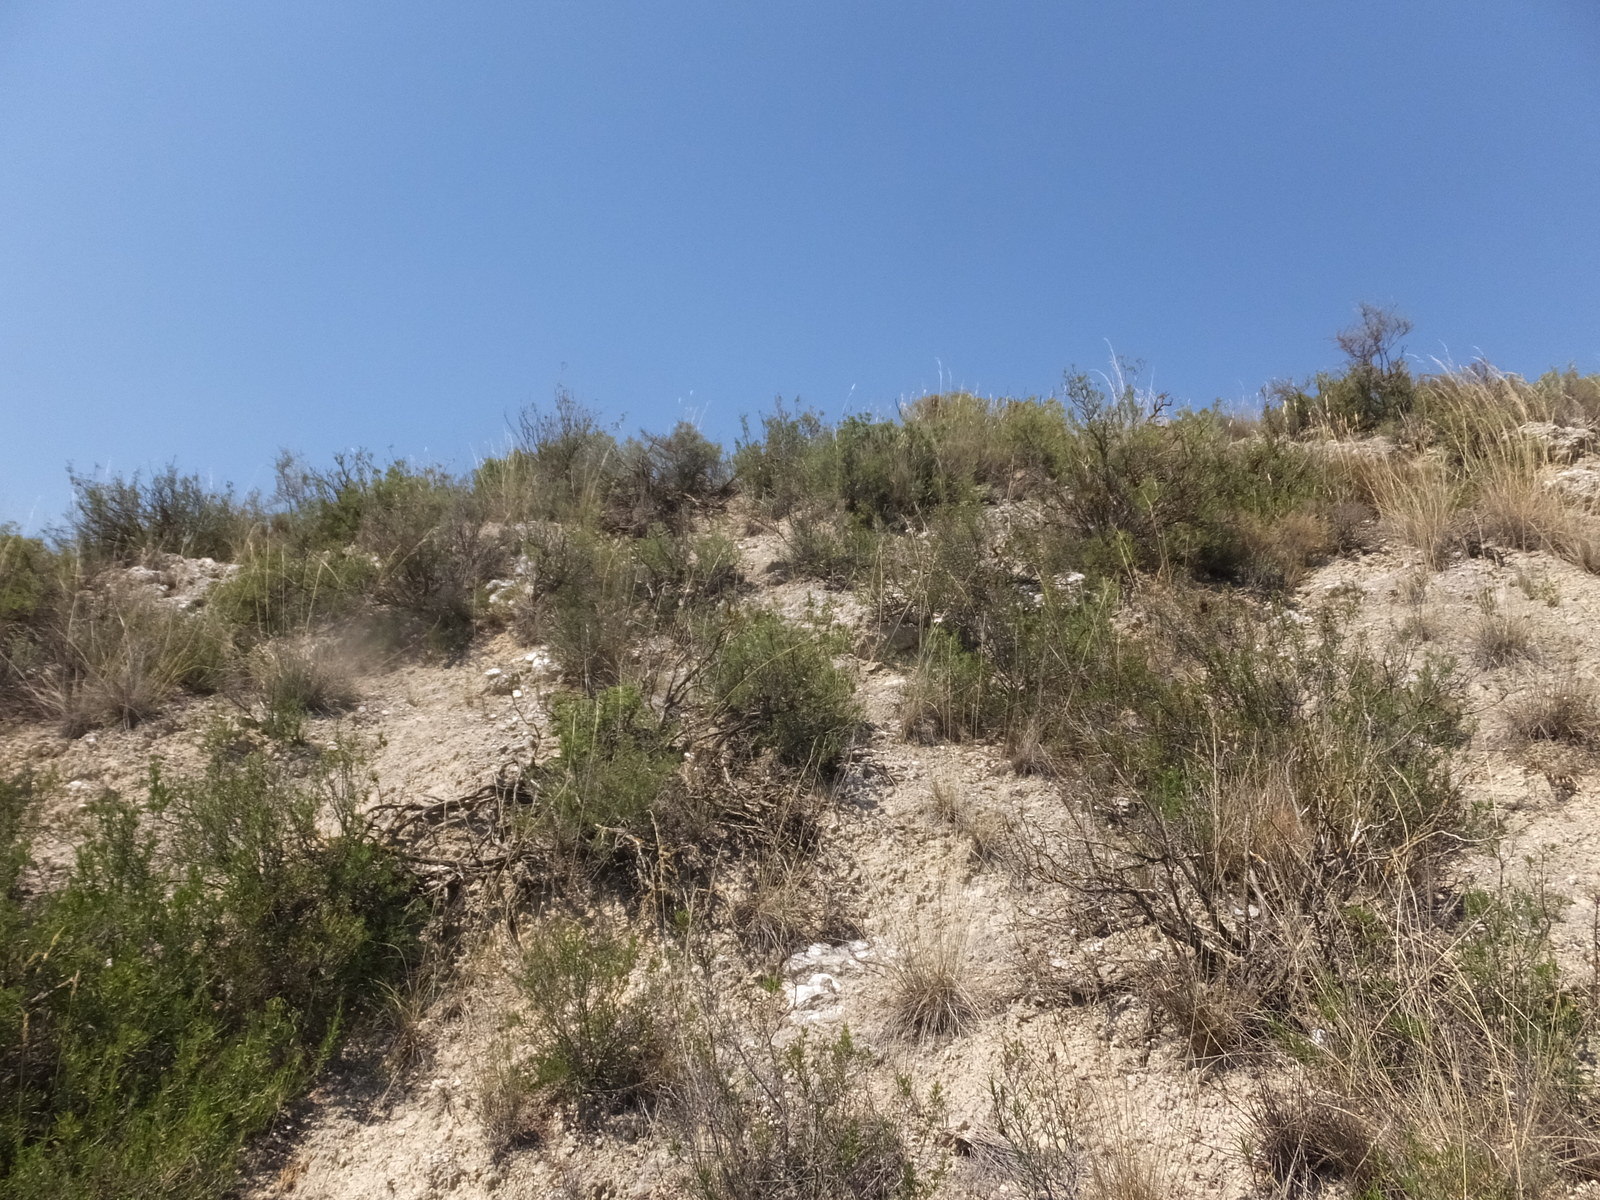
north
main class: Shrubland
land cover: Shrubland with sparse tree cover
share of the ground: 50 - 75 %
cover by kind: shrubs 50 %, herbaceous plants 25 %, consolidated bare surface 20 %, coniferous forest trees 5 %
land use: Semi-natural and natural areas not in use
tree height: < 5 m
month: June
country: ES
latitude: 41.8617
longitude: 0.5044
